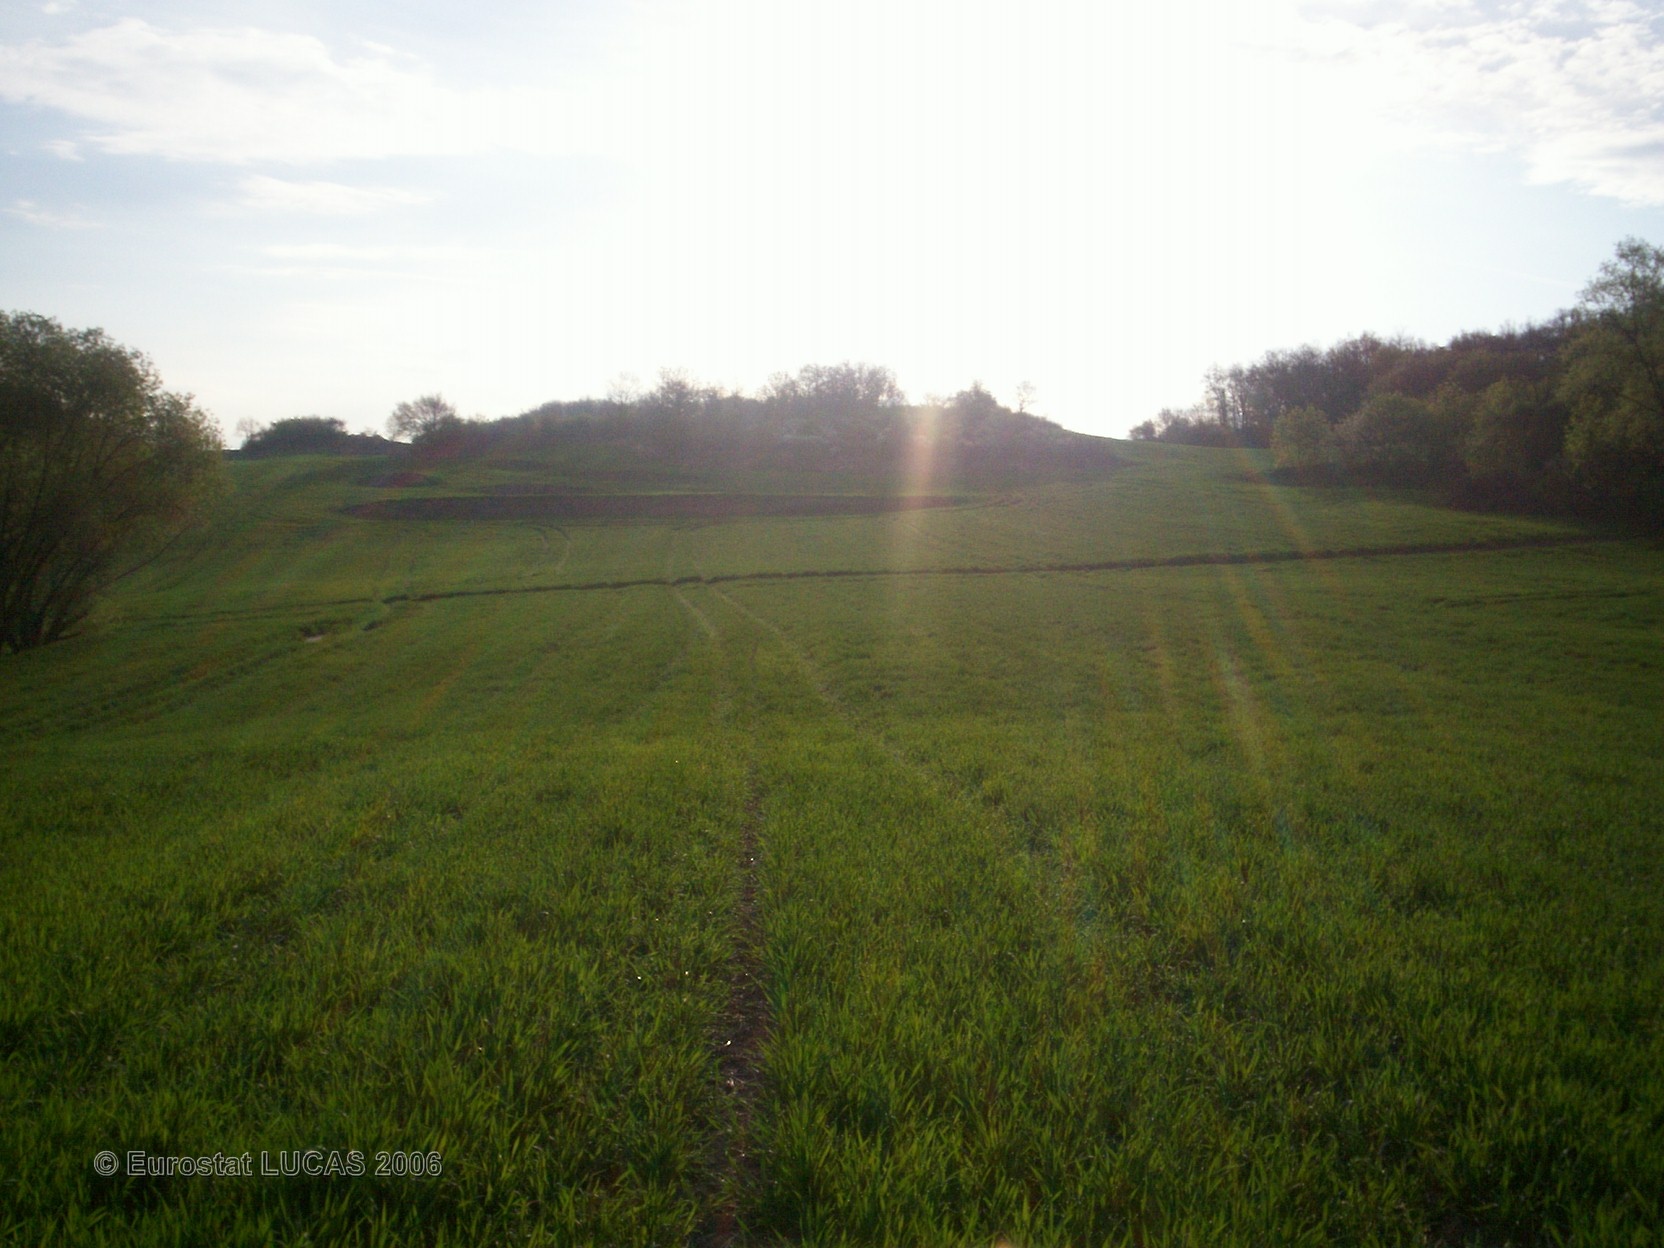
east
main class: Cropland
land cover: Common wheat
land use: Agriculture (excluding fallow land and kitchen gardens)
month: April
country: FR
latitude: 45.8202
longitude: 3.0879
